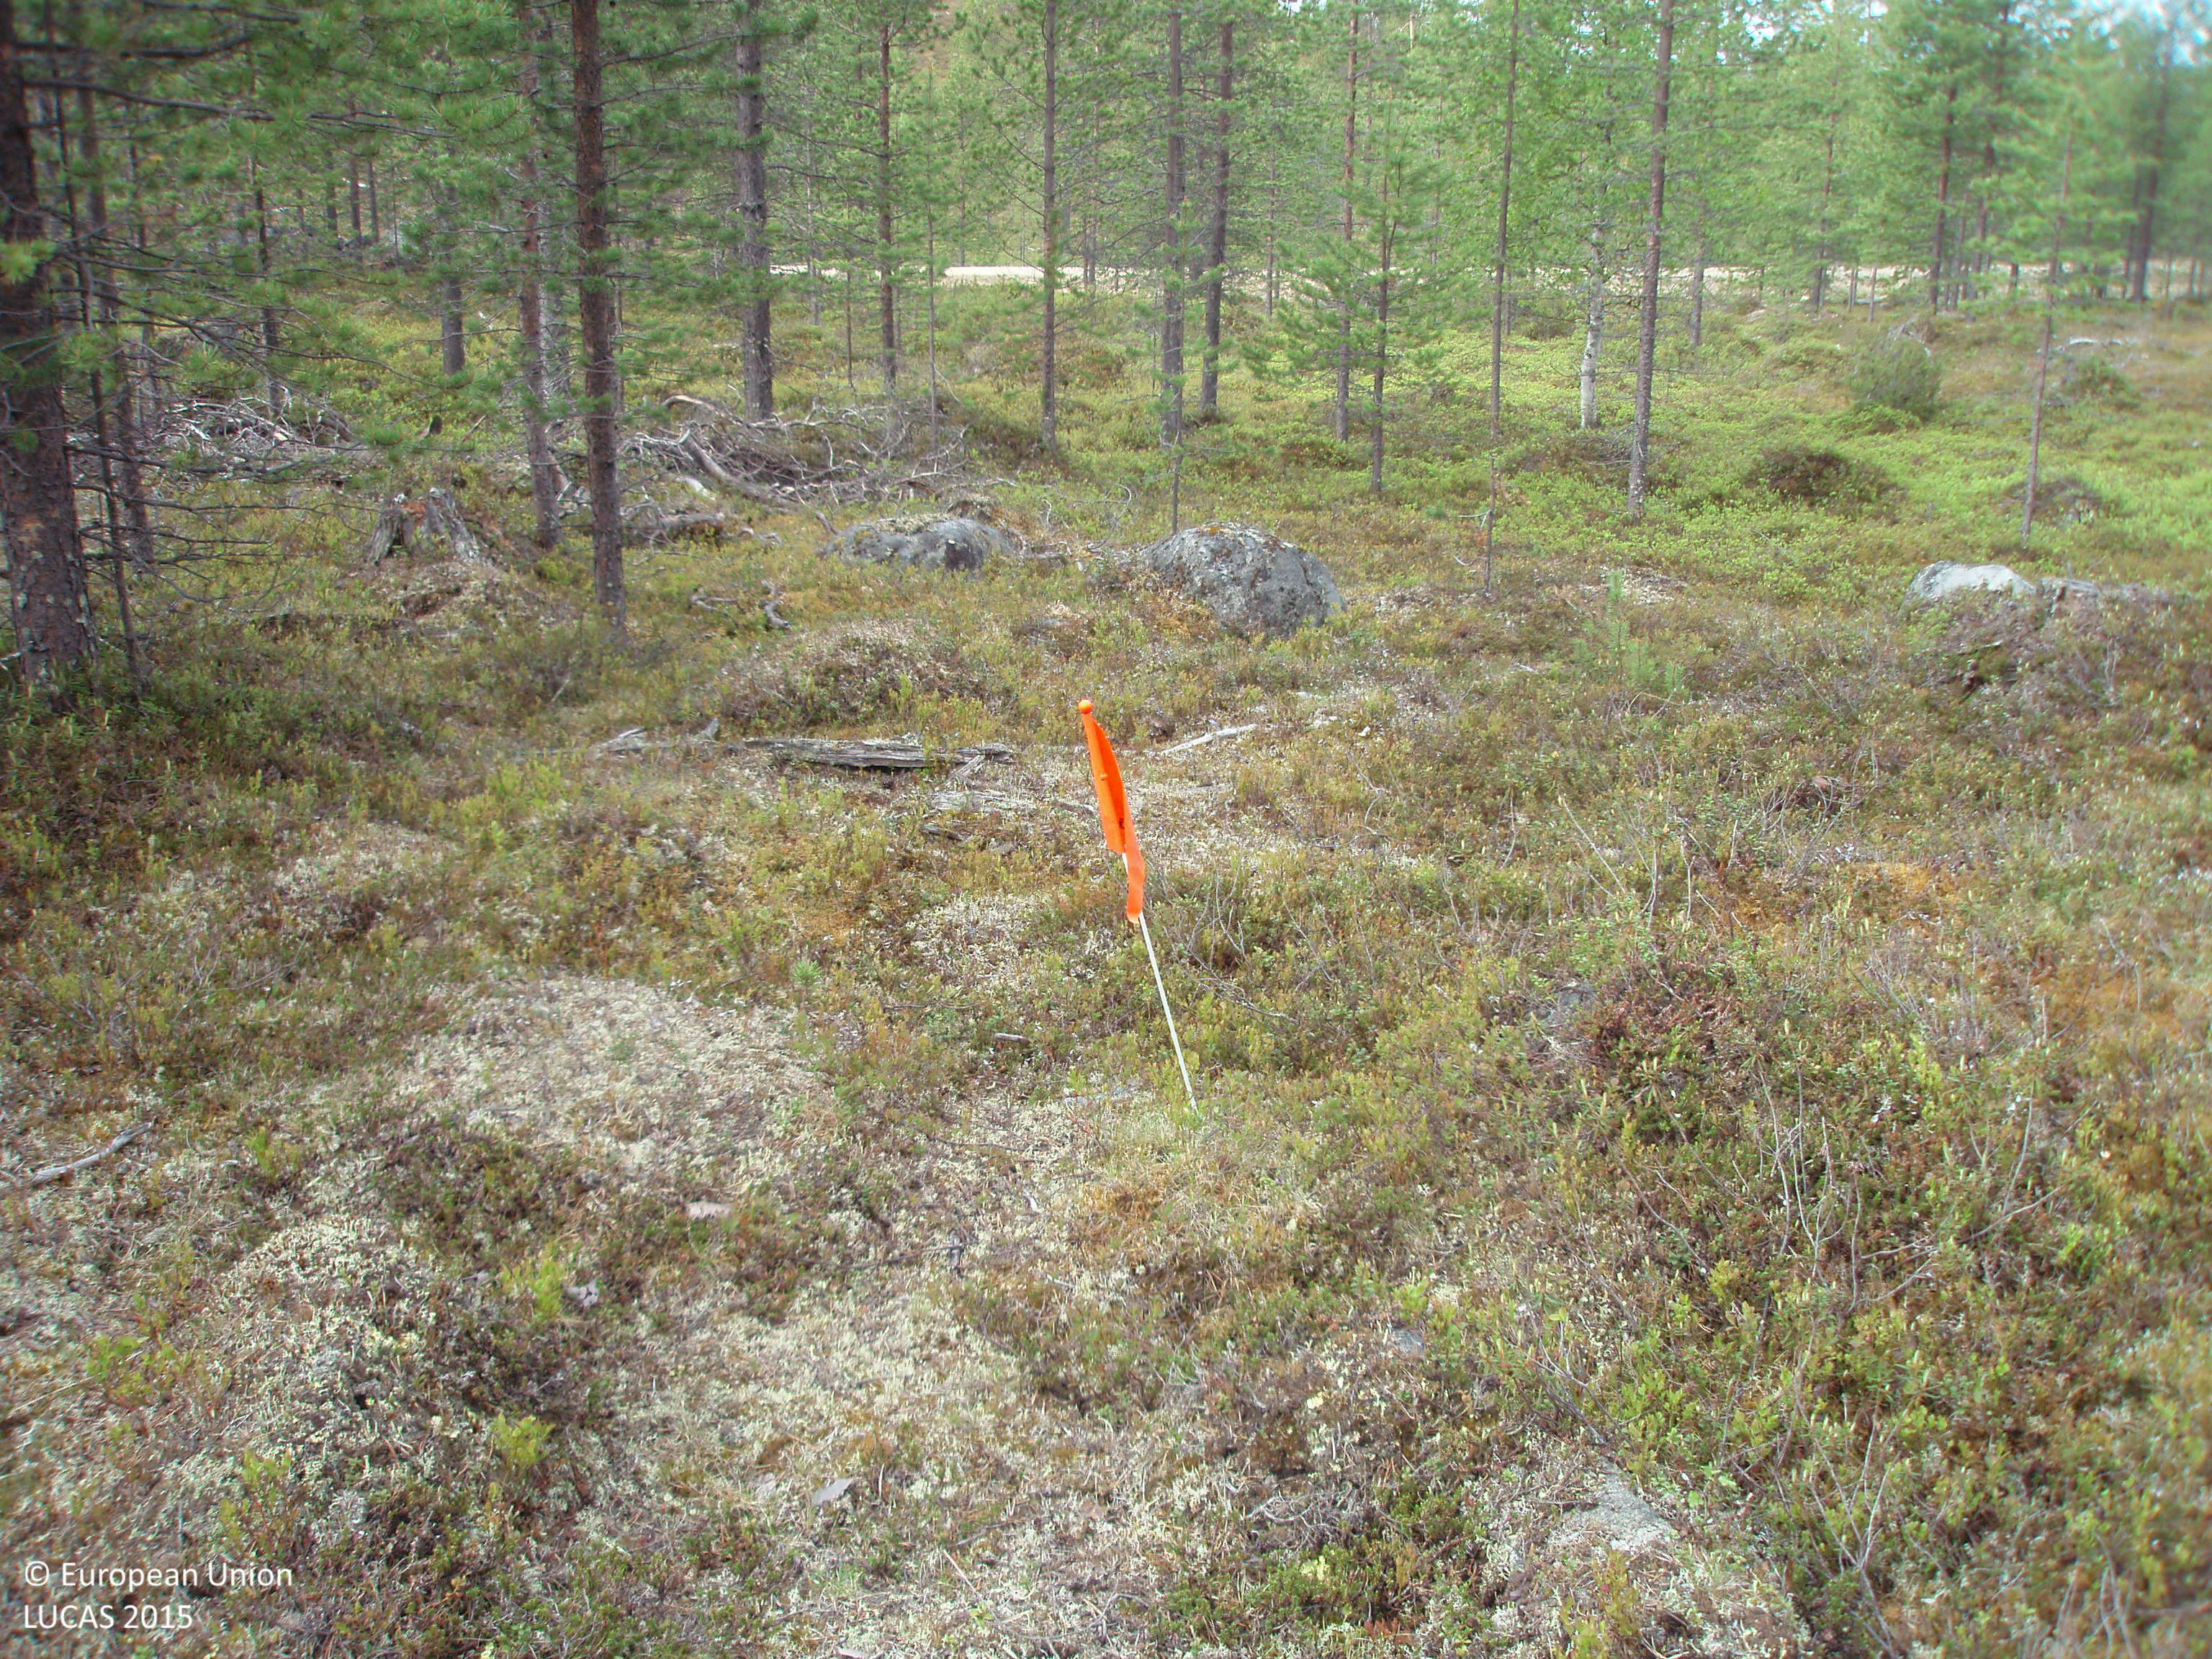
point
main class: Woodland
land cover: Pine dominated coniferous woodland
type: boreal forest
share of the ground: 50 - 75 %
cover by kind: coniferous forest trees 50 %, shrubs 40 %, lichens and mosses 10 %
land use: Forestry
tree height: > 5 m
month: June
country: FI
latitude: 68.8020
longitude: 28.5169
